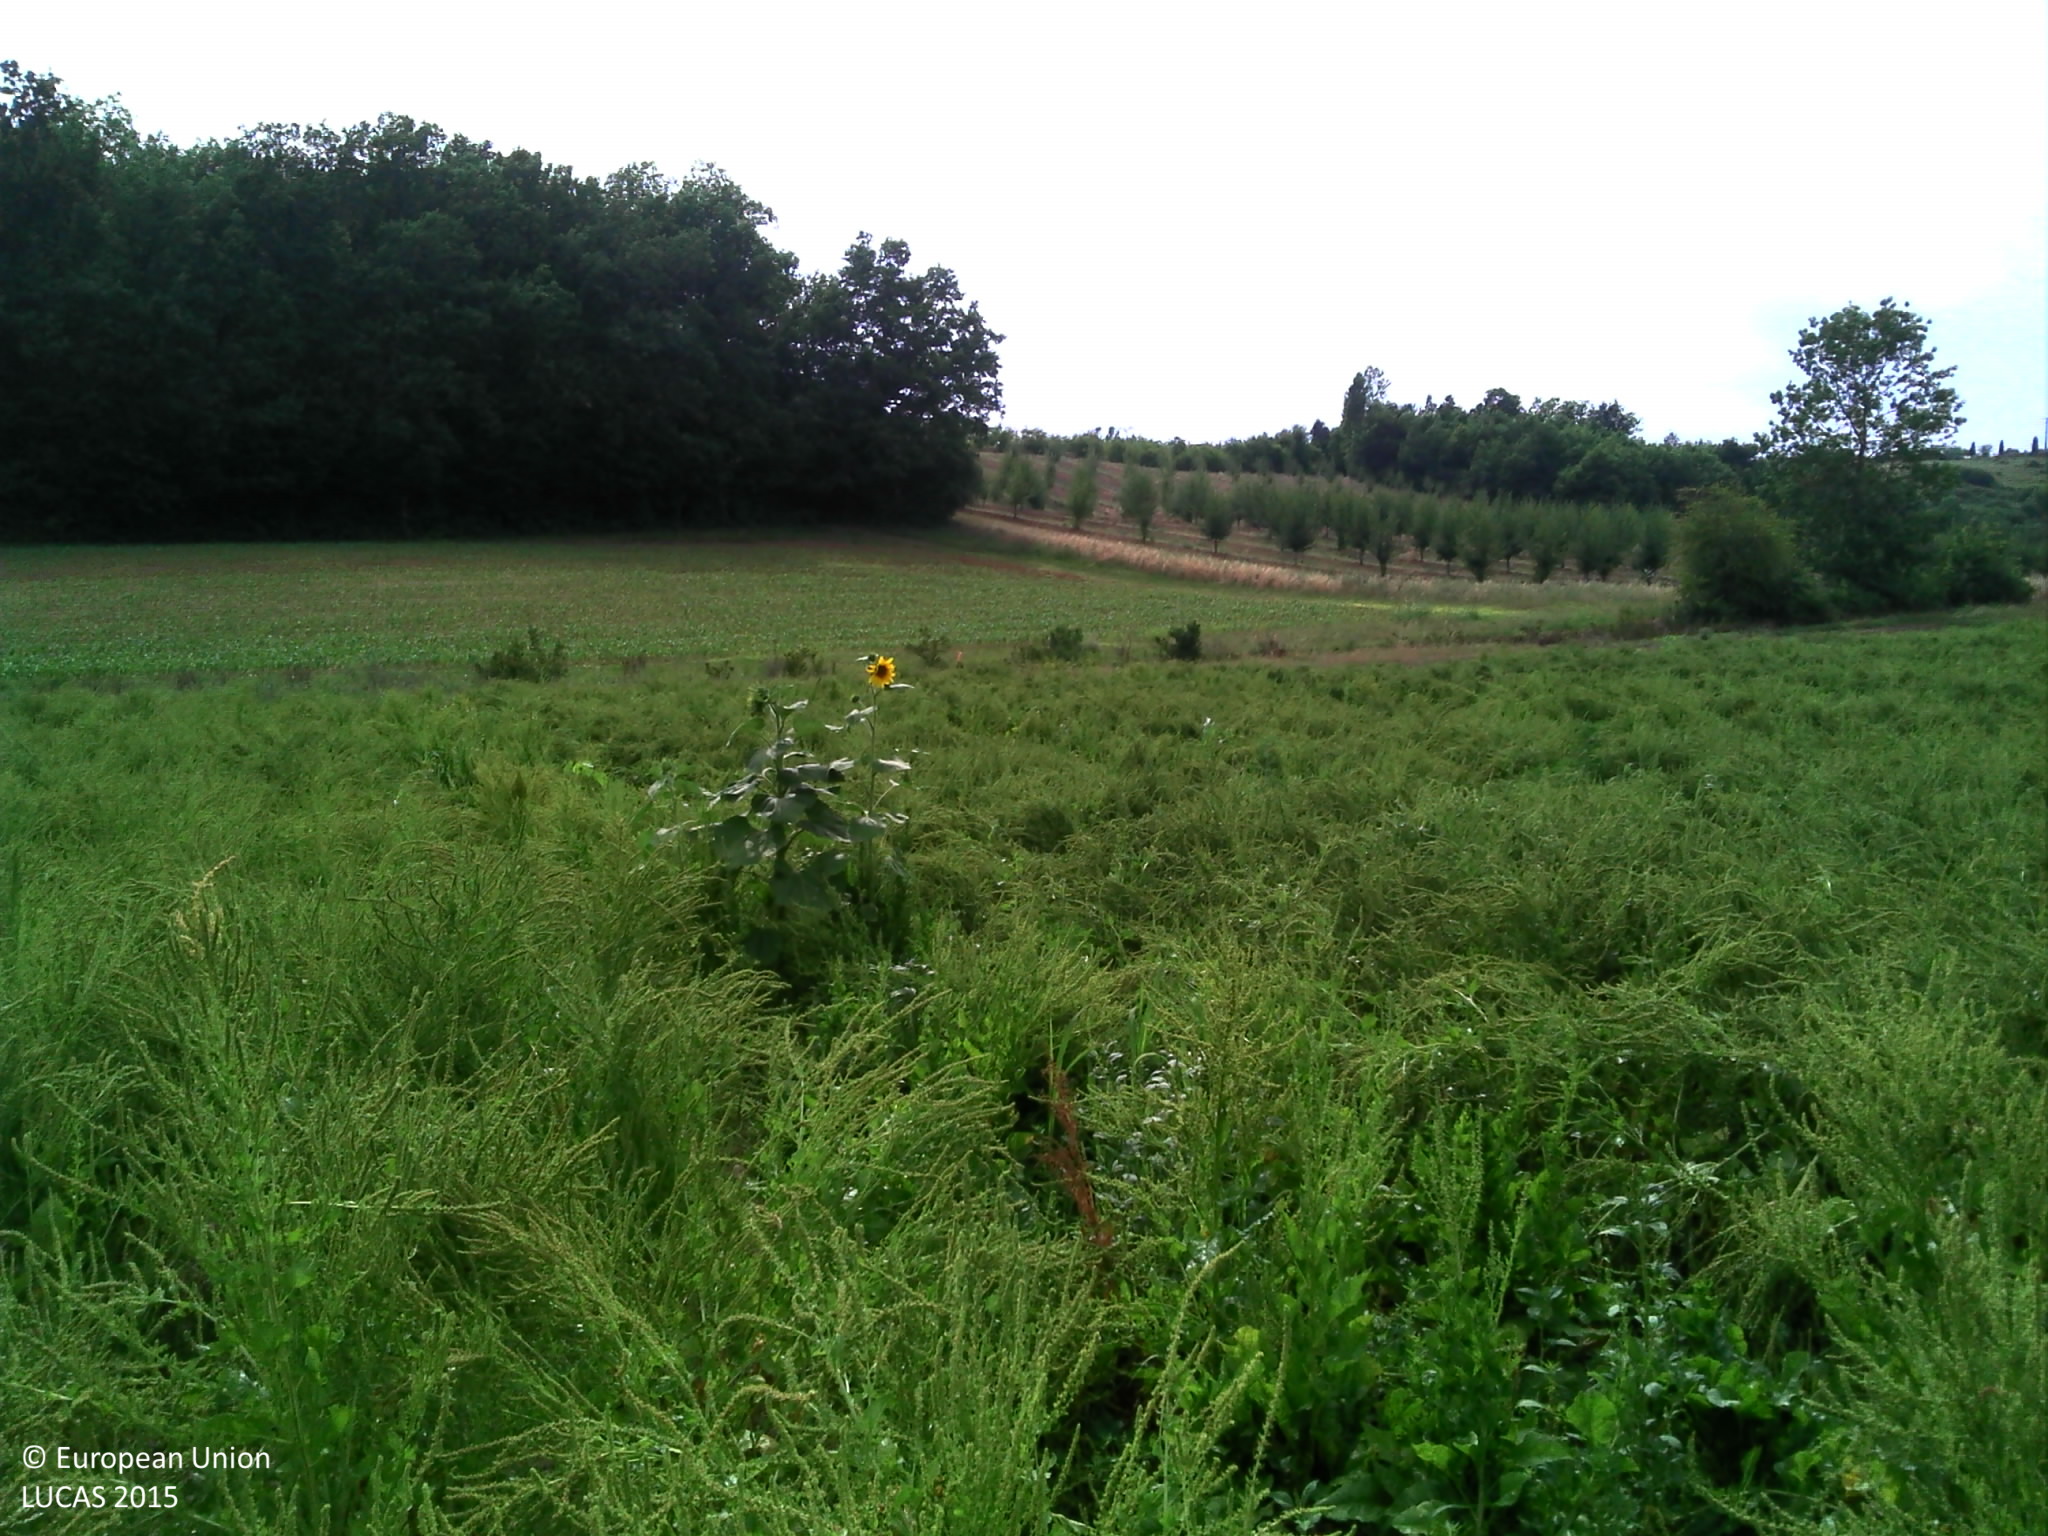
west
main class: Cropland
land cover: Sugar beet
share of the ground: > 75 %
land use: Agriculture (excluding fallow land and kitchen gardens)
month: July
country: FR
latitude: 44.4744
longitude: 0.8805
